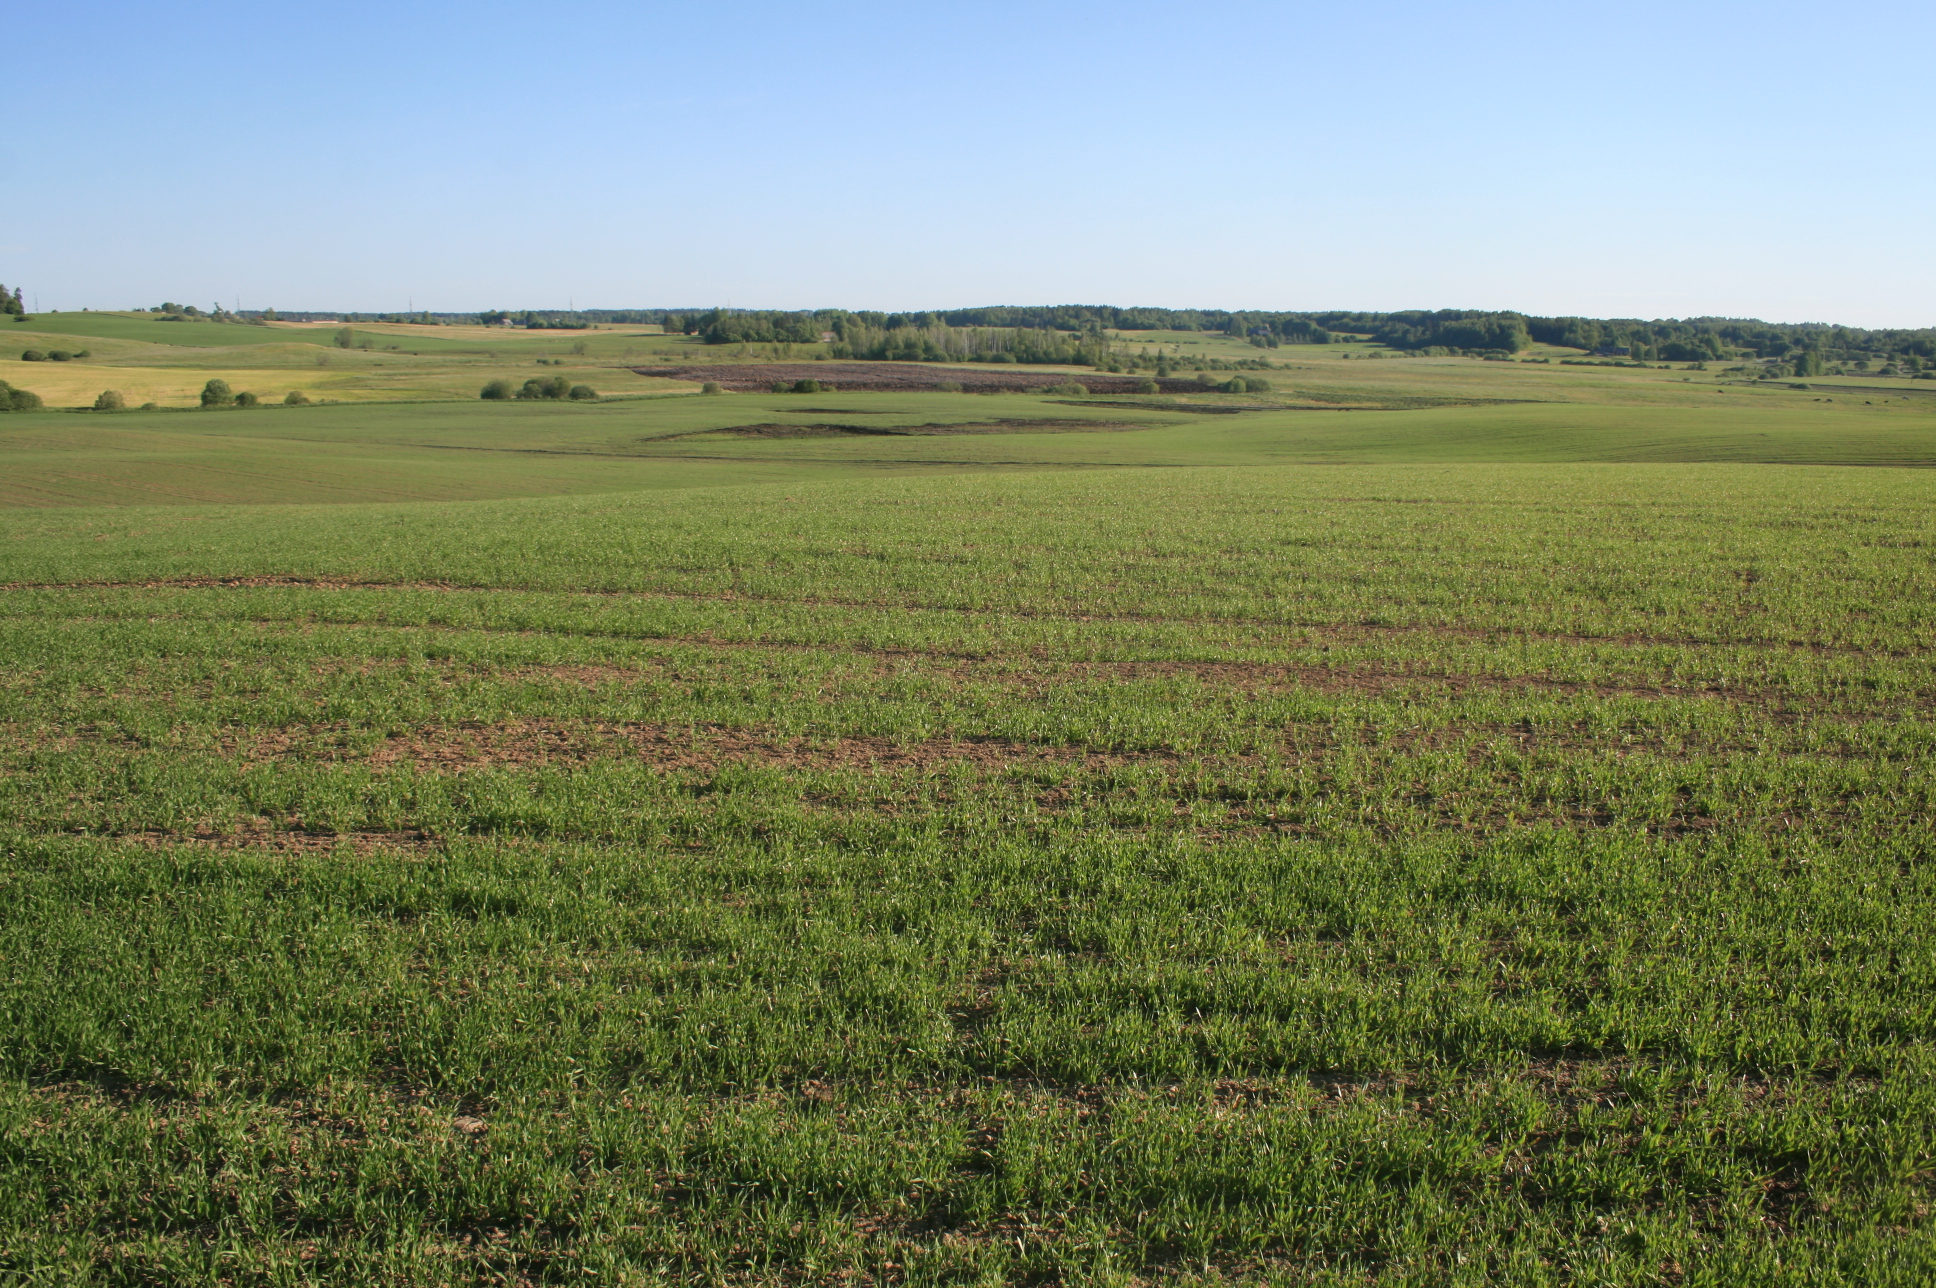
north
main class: Cropland
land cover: Barley
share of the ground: > 75 %
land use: Agriculture (excluding fallow land and kitchen gardens)
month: June
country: LT
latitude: 55.9131
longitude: 22.0028
